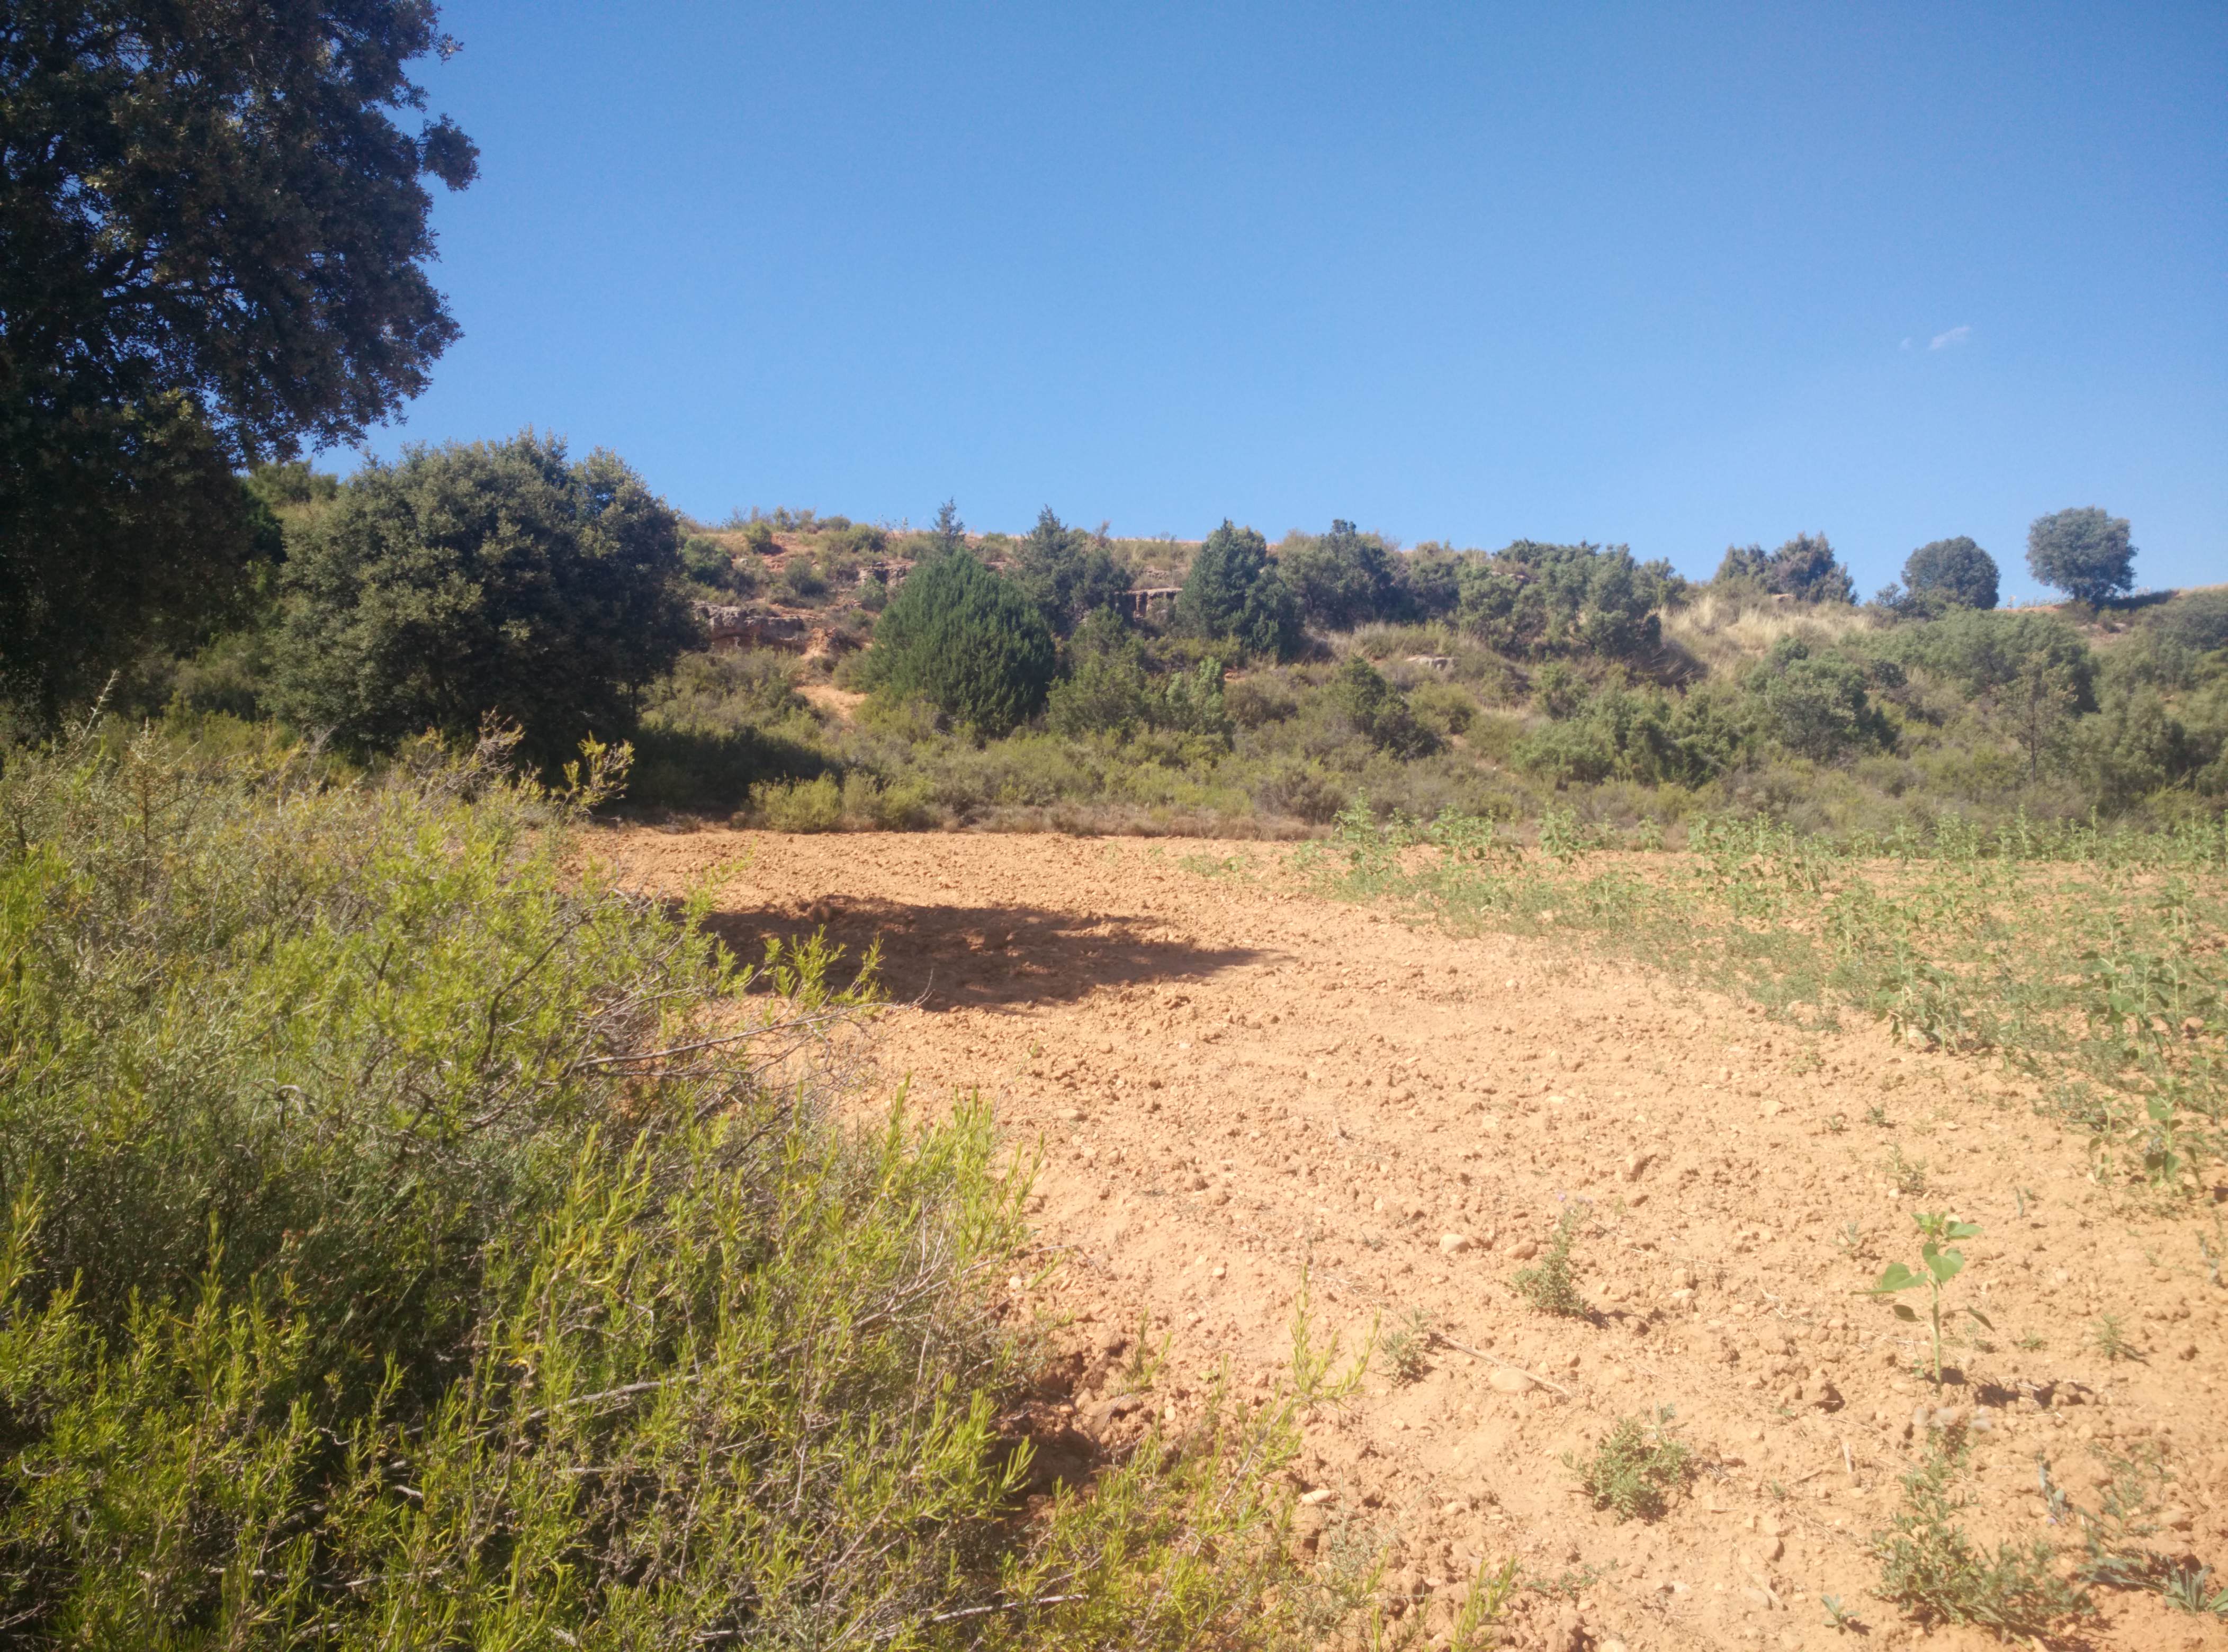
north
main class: Shrubland
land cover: Shrubland with sparse tree cover
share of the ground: > 75 %
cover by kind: shrubs 85 %, unconsolidated bare surface 10 %, broadleaved forest trees 5 %
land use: Semi-natural and natural areas not in use
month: July
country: ES
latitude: 40.8155
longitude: -2.6557
